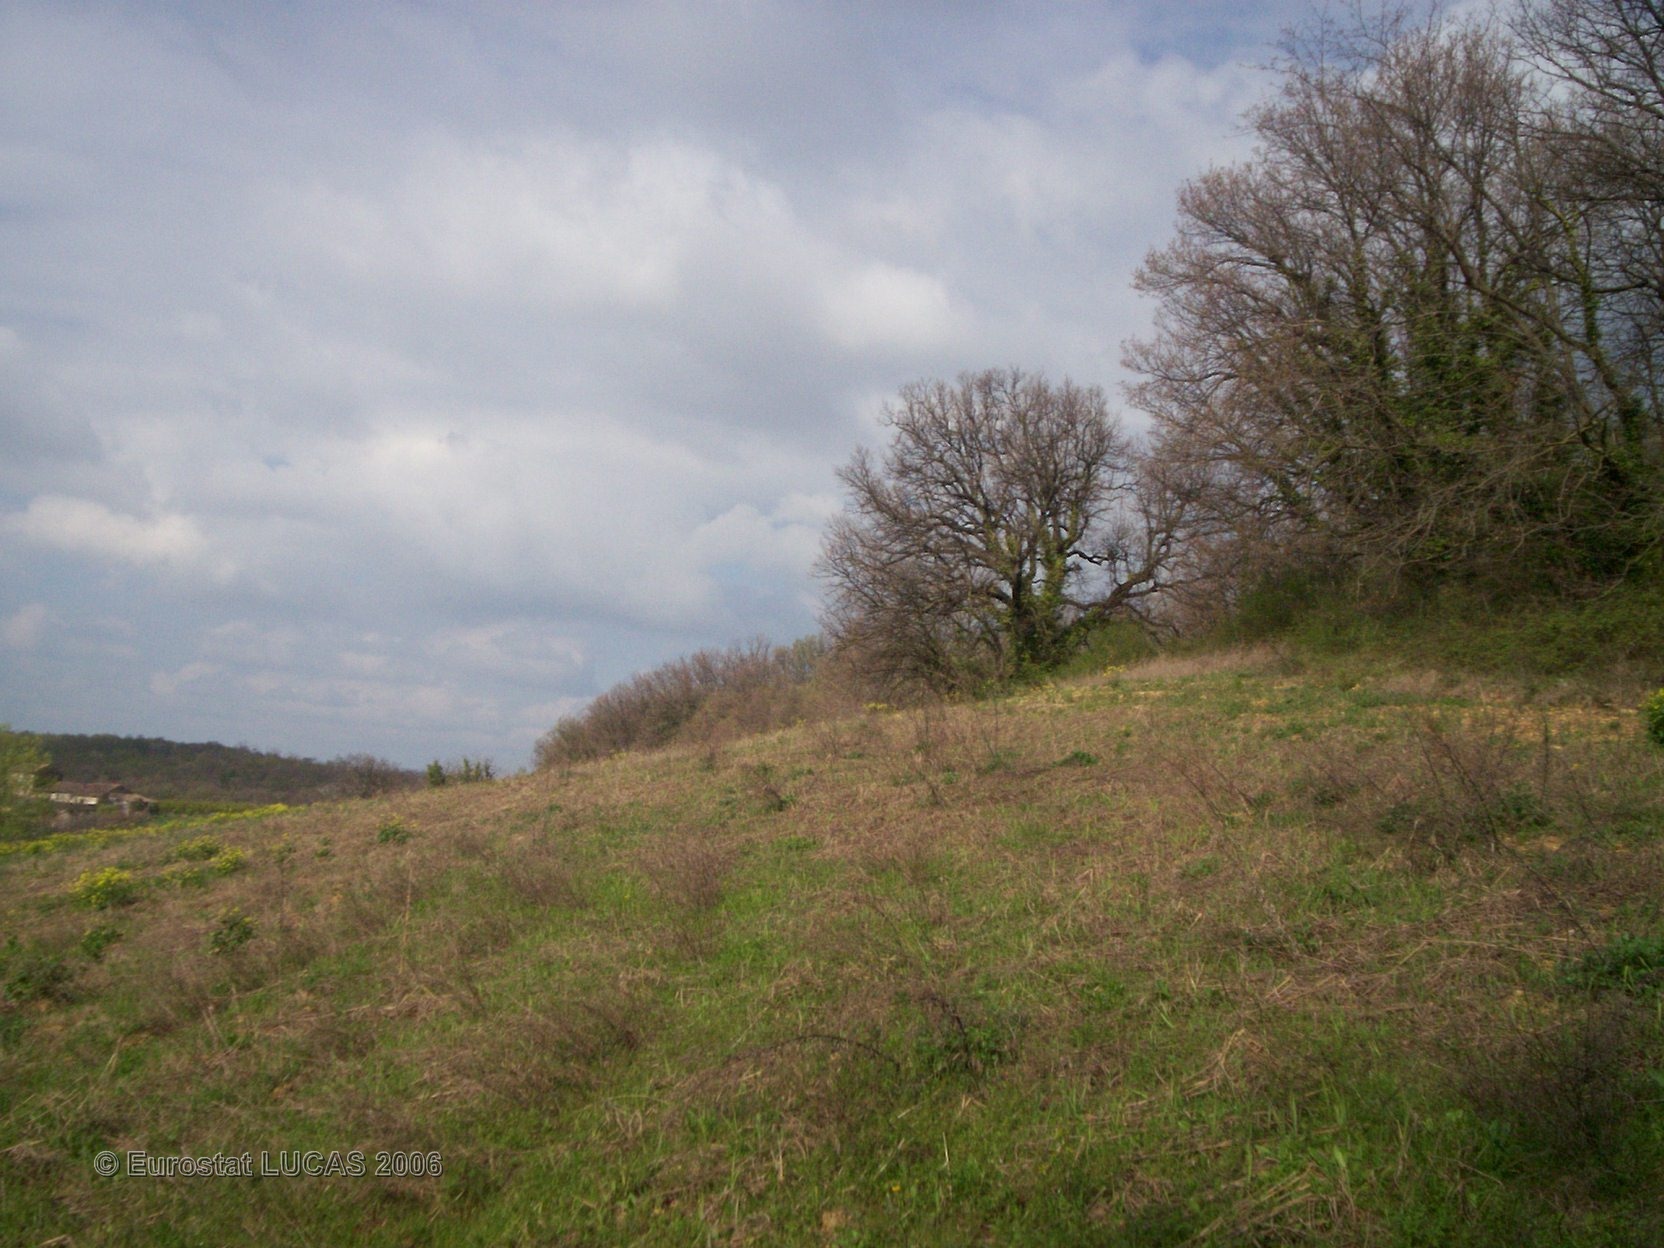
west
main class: Grassland
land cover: Grassland without tree/shrub cover
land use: Fallow land
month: April
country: FR
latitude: 44.7846
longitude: 4.8875
